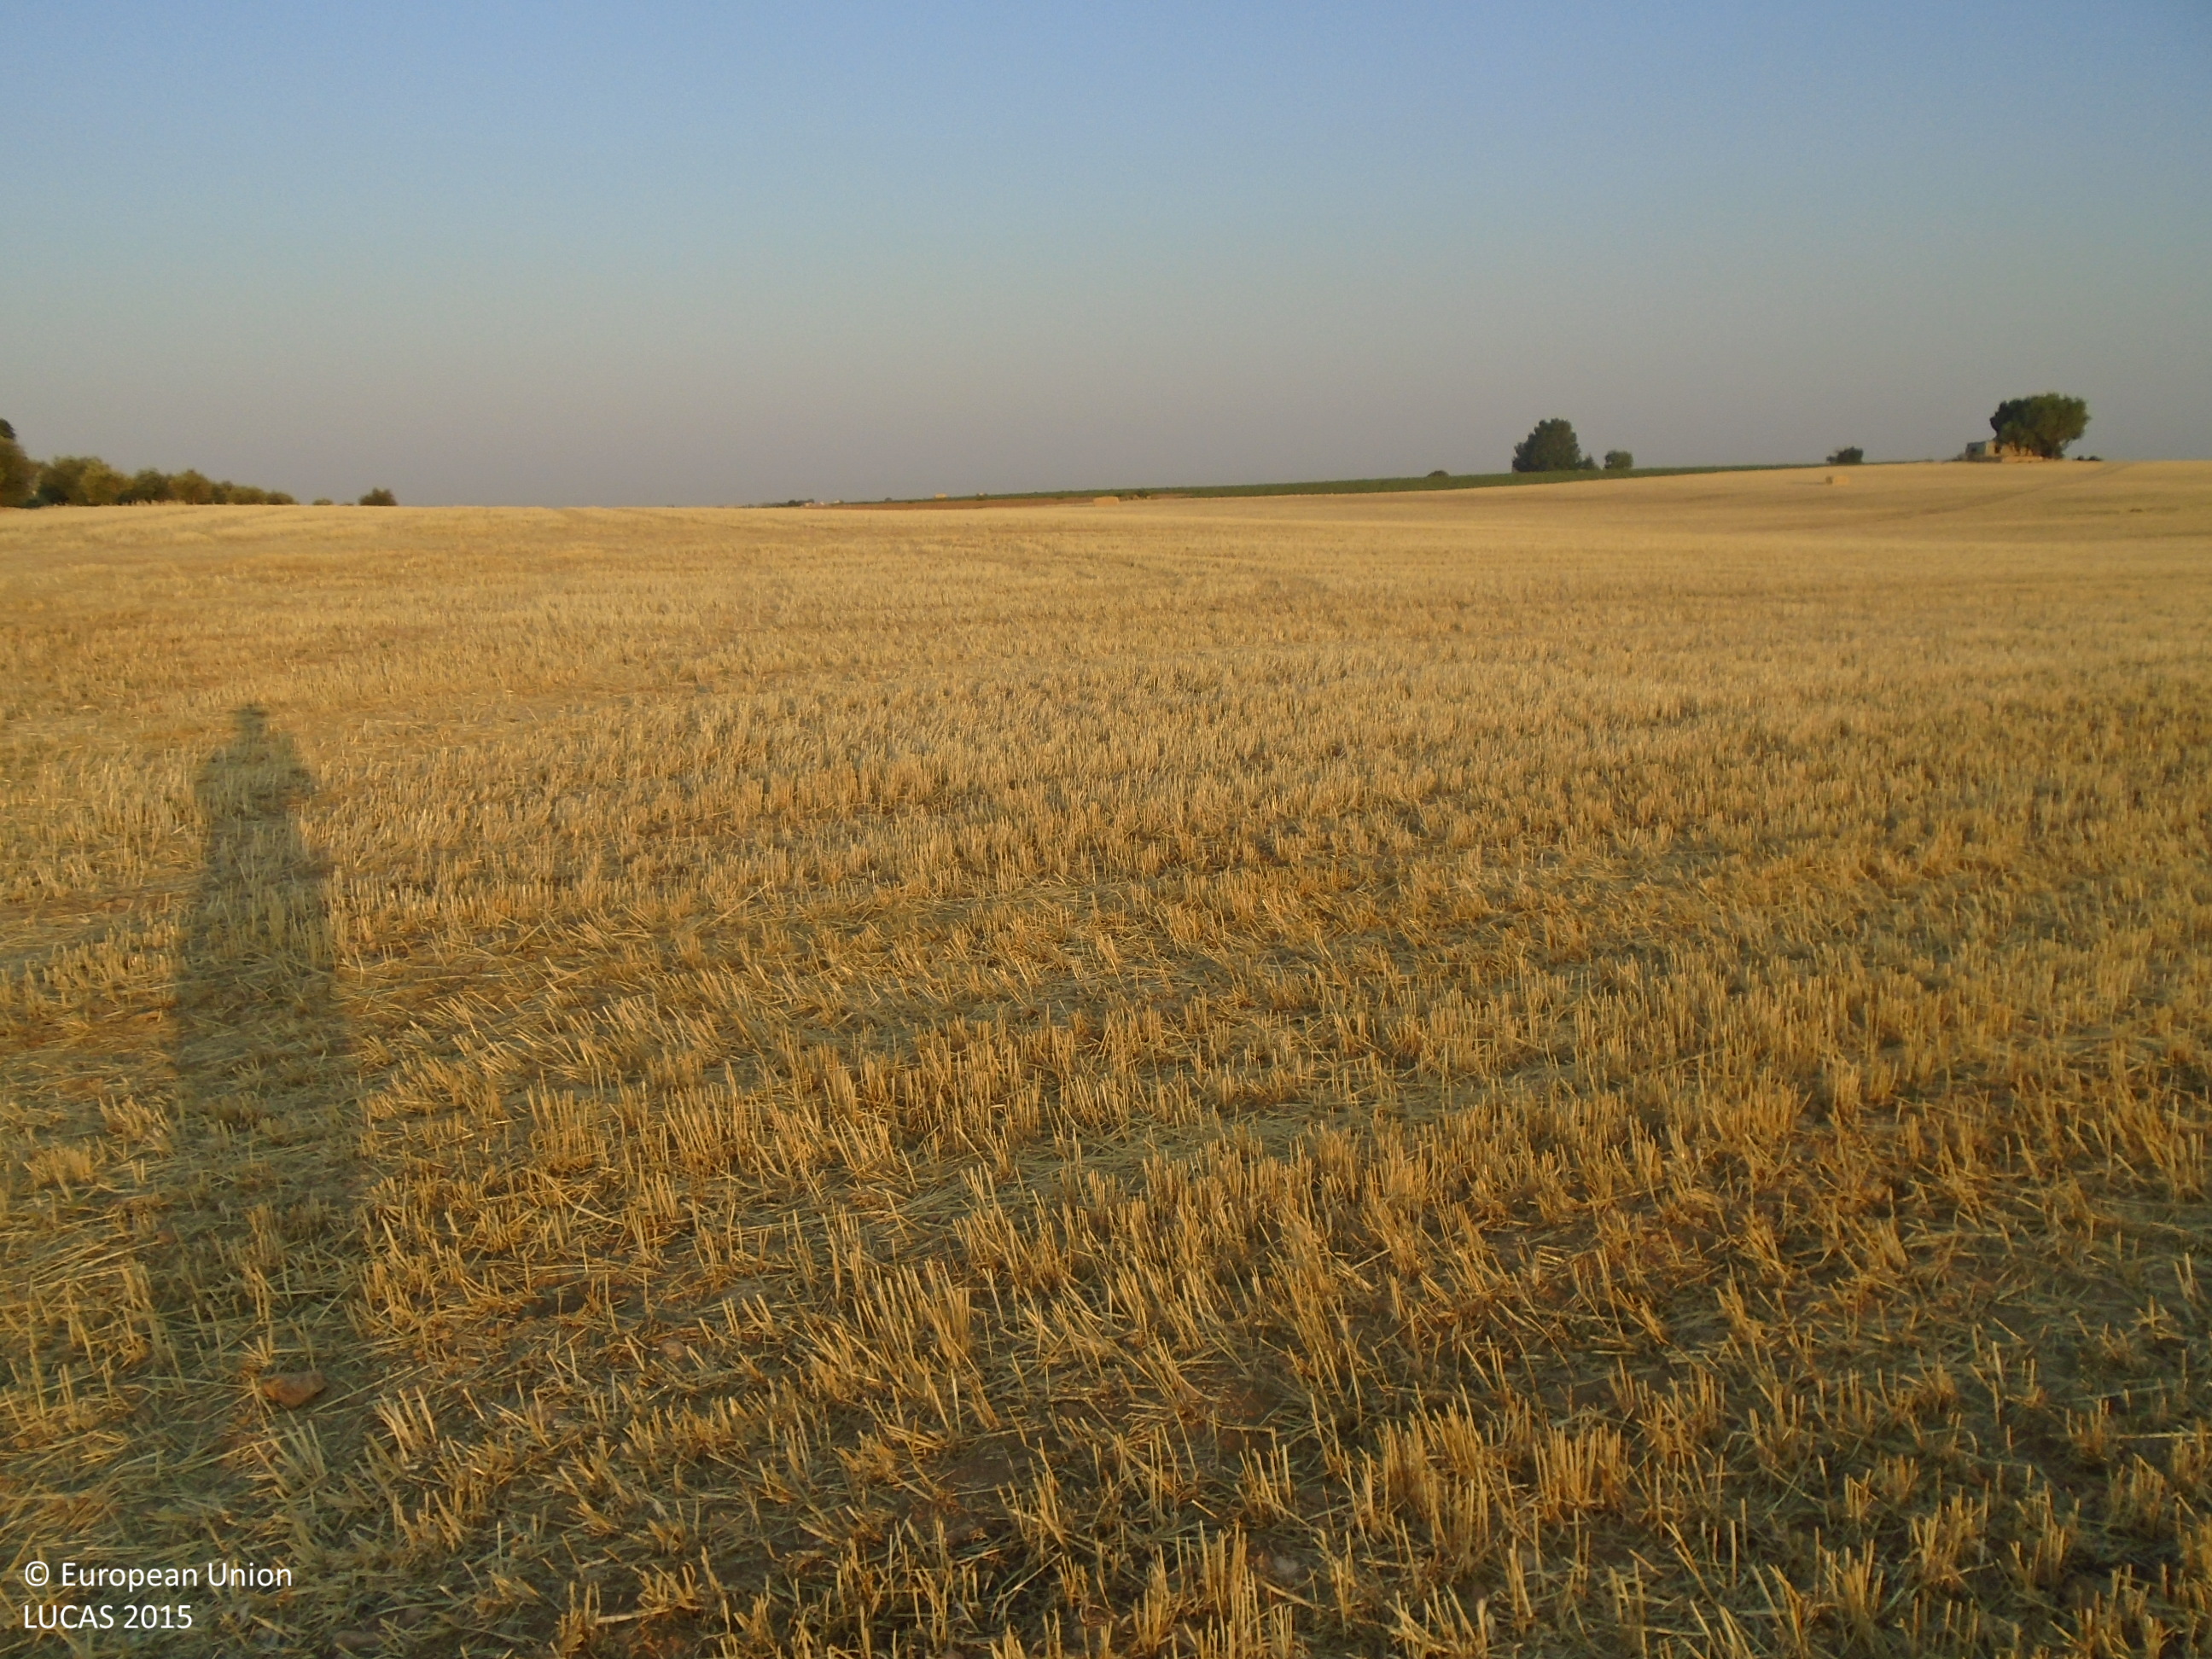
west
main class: Cropland
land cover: Barley
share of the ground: > 75 %
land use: Agriculture (excluding fallow land and kitchen gardens)
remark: Harvested field
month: June
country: ES
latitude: 39.1096
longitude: -3.6302
